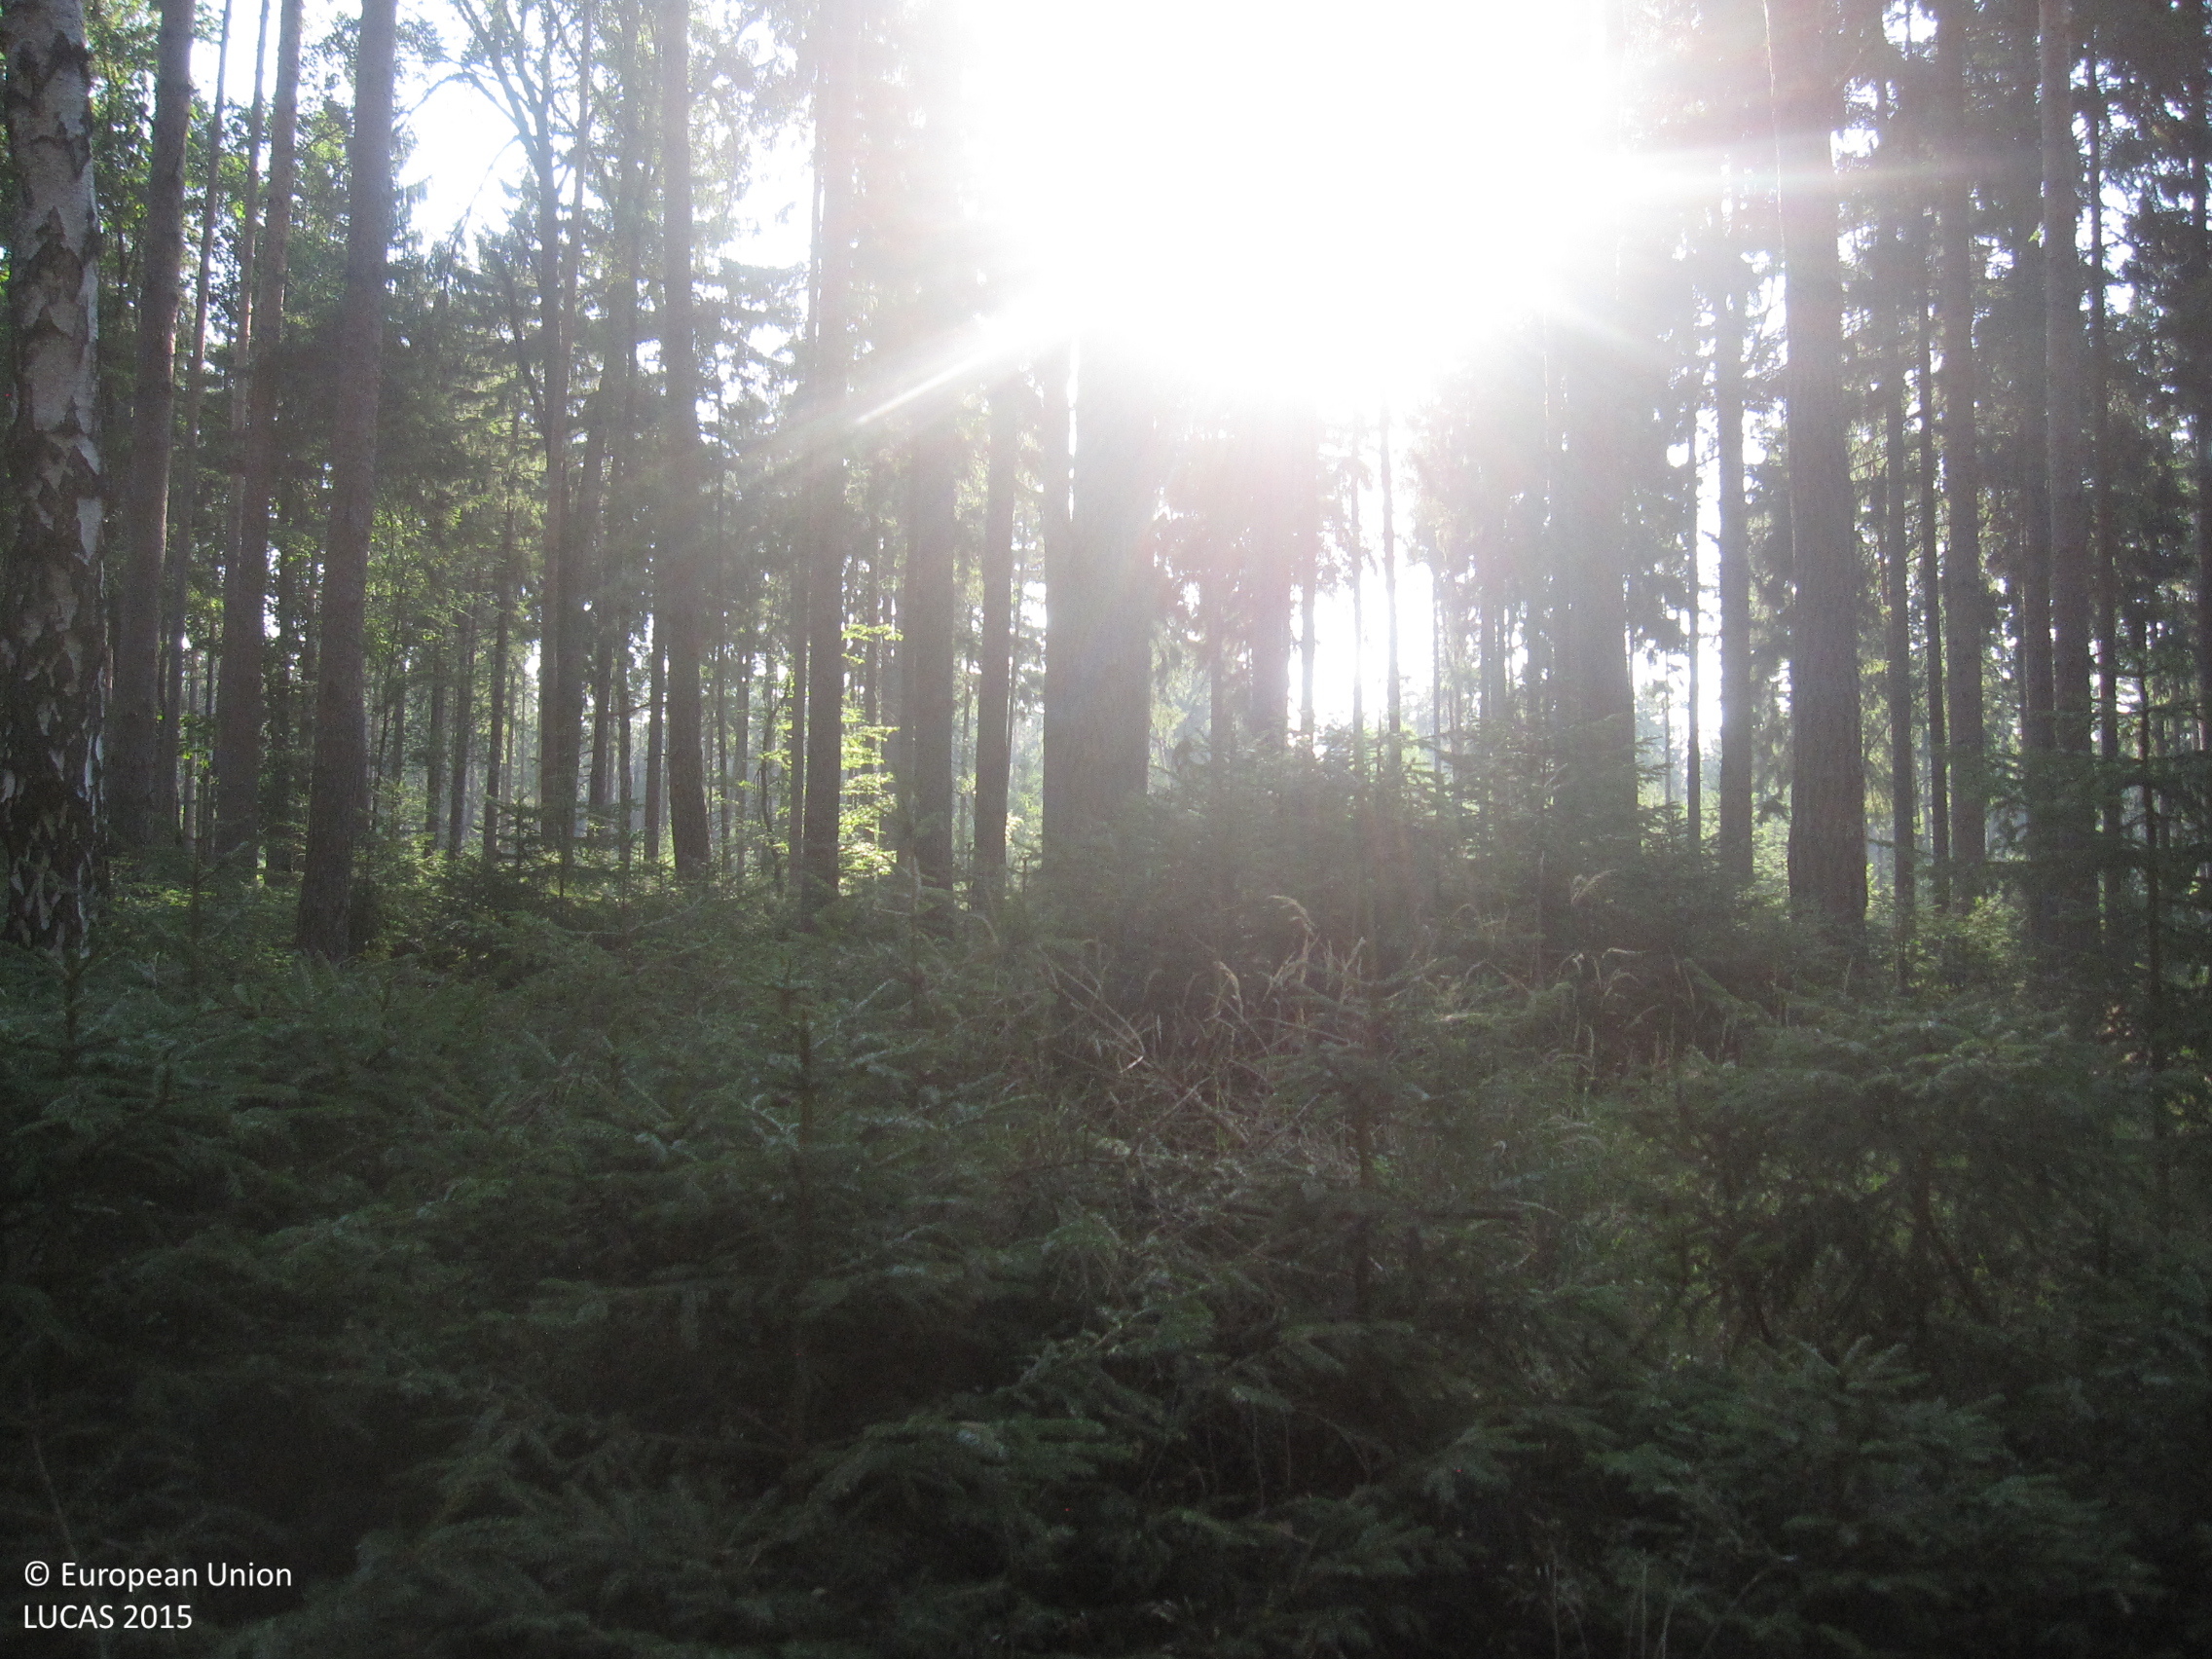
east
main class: Woodland
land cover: Spruce dominated coniferous woodland
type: hemiboreal forest and nemoral coniferous forest and mixed broadleaved-coniferous forest
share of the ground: > 75 %
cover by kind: coniferous forest trees 75 %, lichens and mosses 15 %, herbaceous plants 10 %
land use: Forestry
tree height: > 5 m
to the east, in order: Spruce dominated coniferous woodland; Ditches and canals; Tracks; Ditches and canals; Spruce dominated coniferous woodland; Tracks; Spruce dominated coniferous woodland
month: August
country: DE
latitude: 50.6335
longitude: 12.0497
